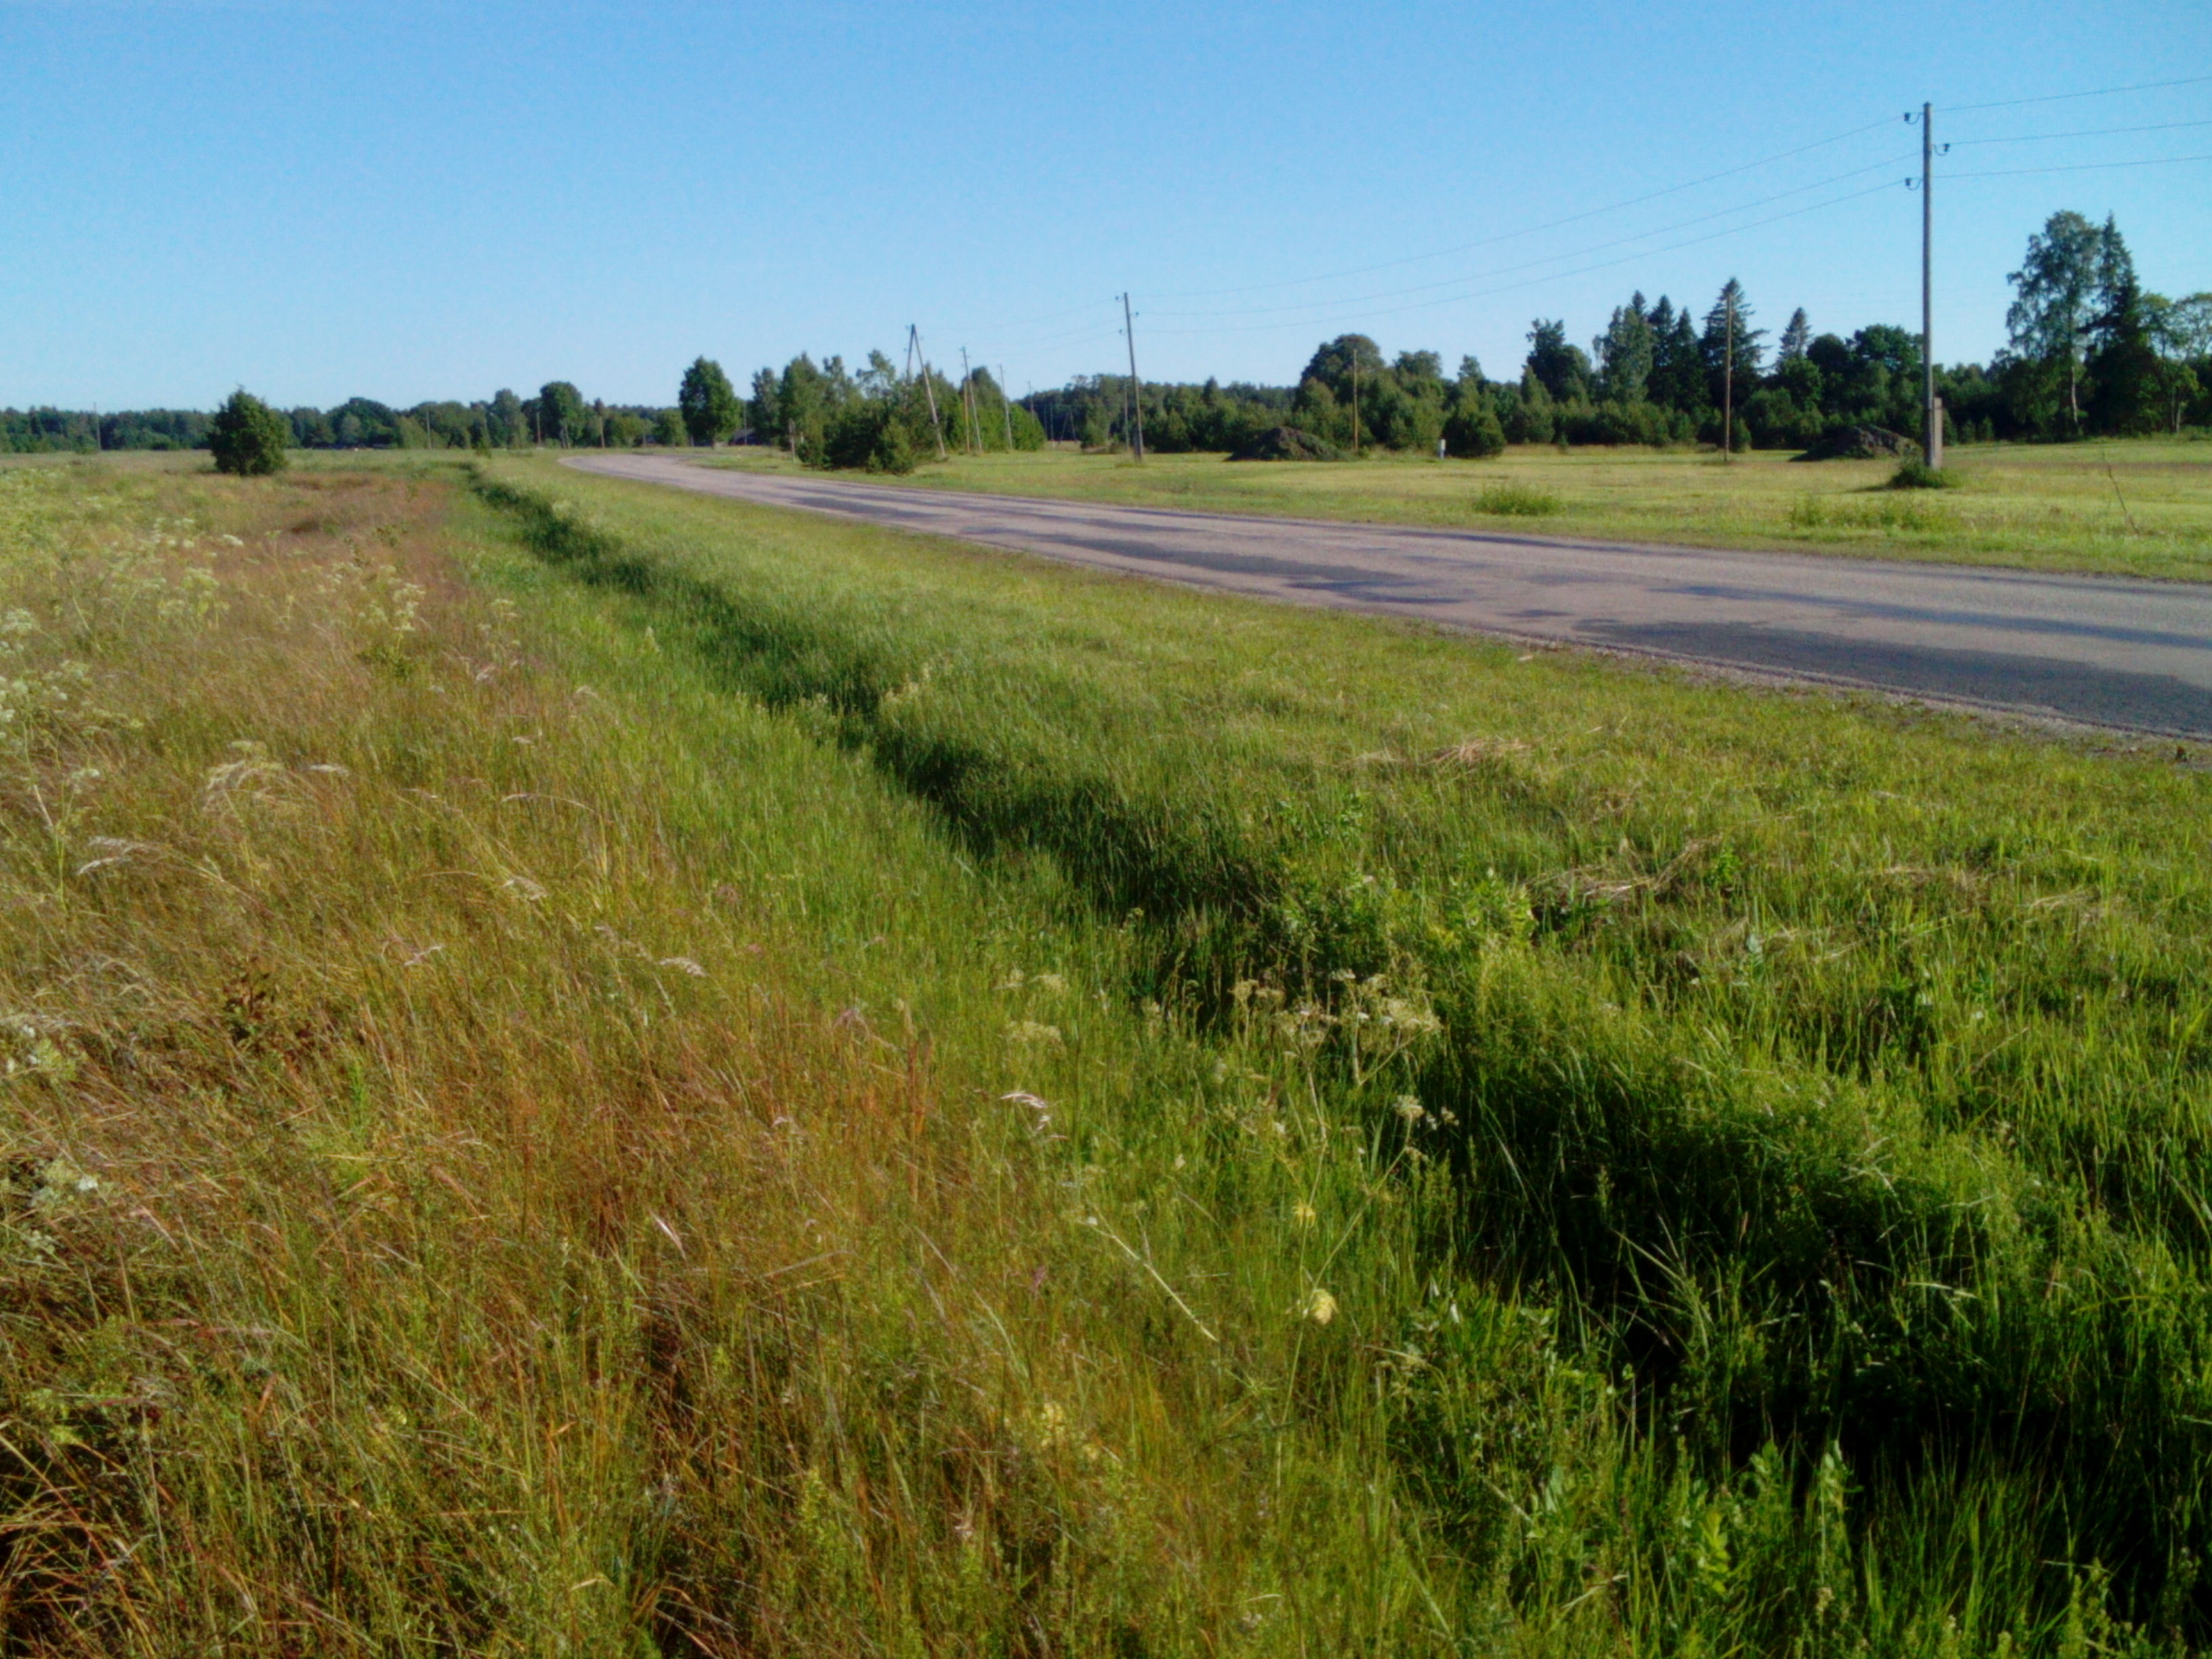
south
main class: Grassland
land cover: Grassland with sparse tree/shrub cover
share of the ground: > 75 %
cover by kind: herbaceous plants 95 %, broadleaved forest trees 5 %
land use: Semi-natural and natural areas not in use
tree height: < 5 m
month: June
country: LV
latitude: 56.8201
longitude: 21.2274
